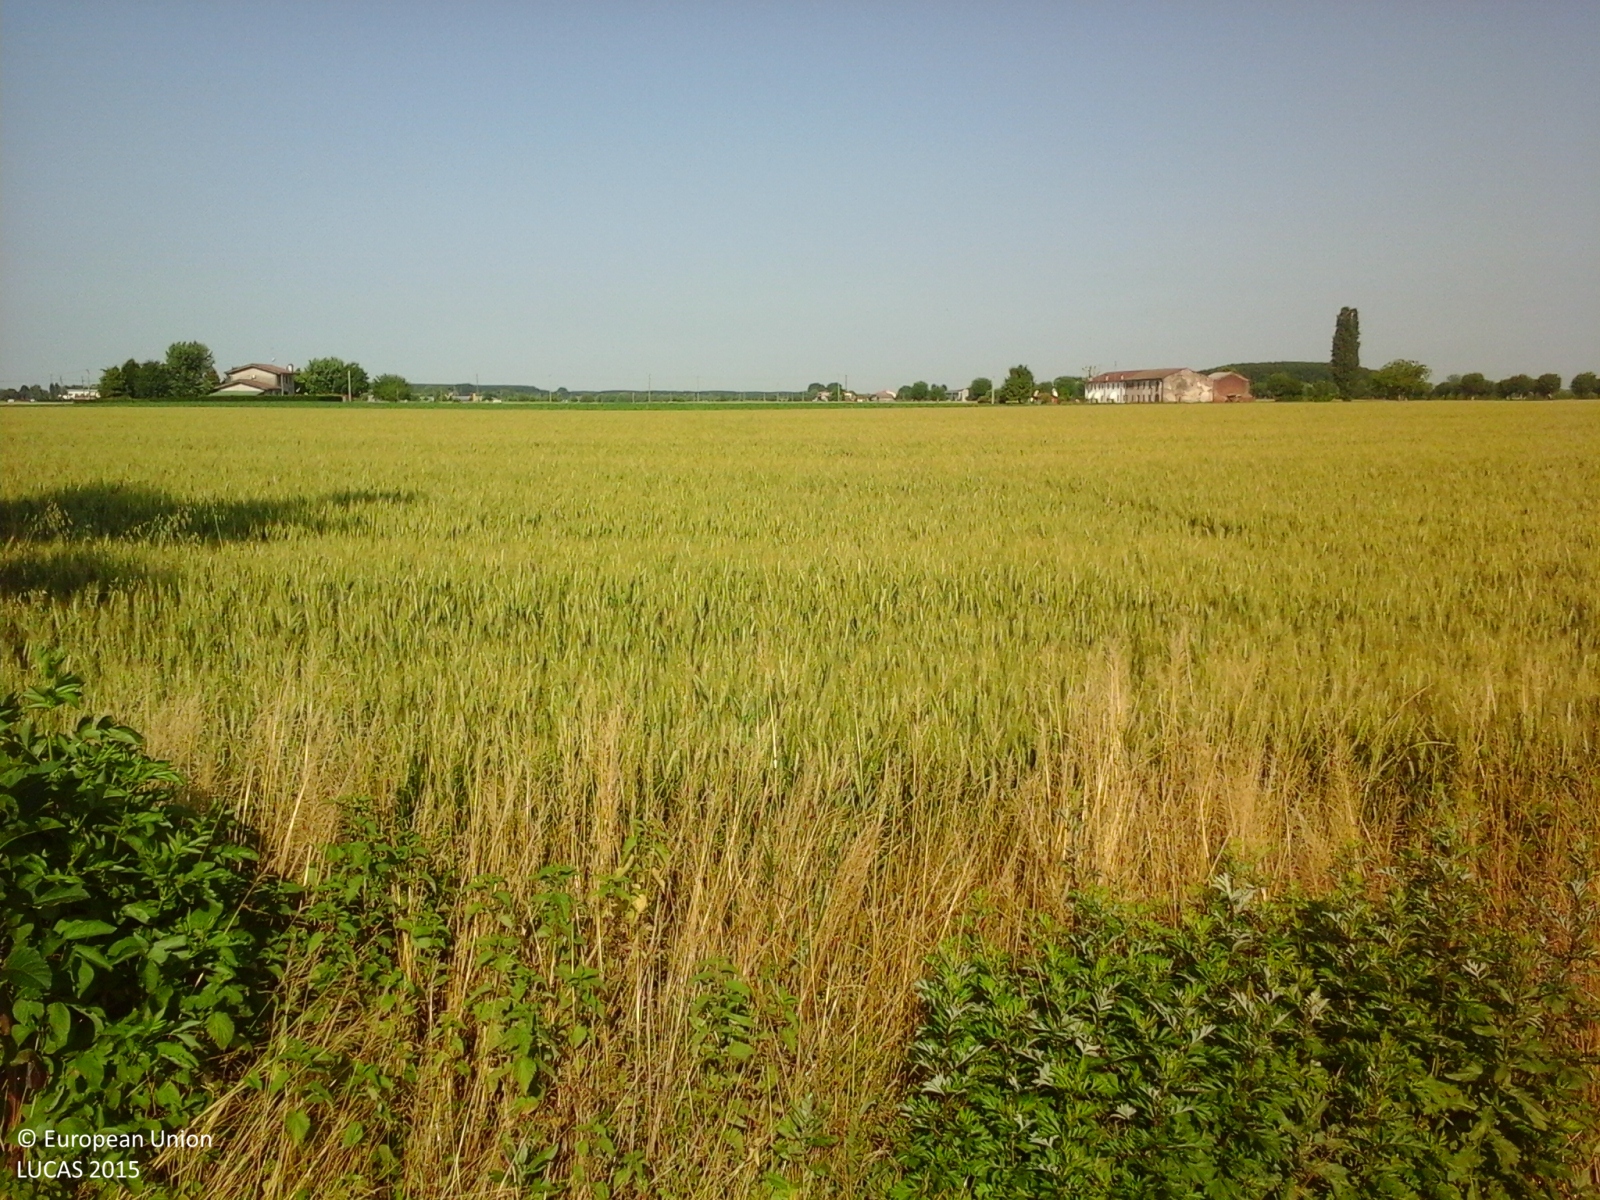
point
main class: Cropland
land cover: Common wheat
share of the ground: > 75 %
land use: Agriculture (excluding fallow land and kitchen gardens)
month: May
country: IT
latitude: 45.1930
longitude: 11.0291
